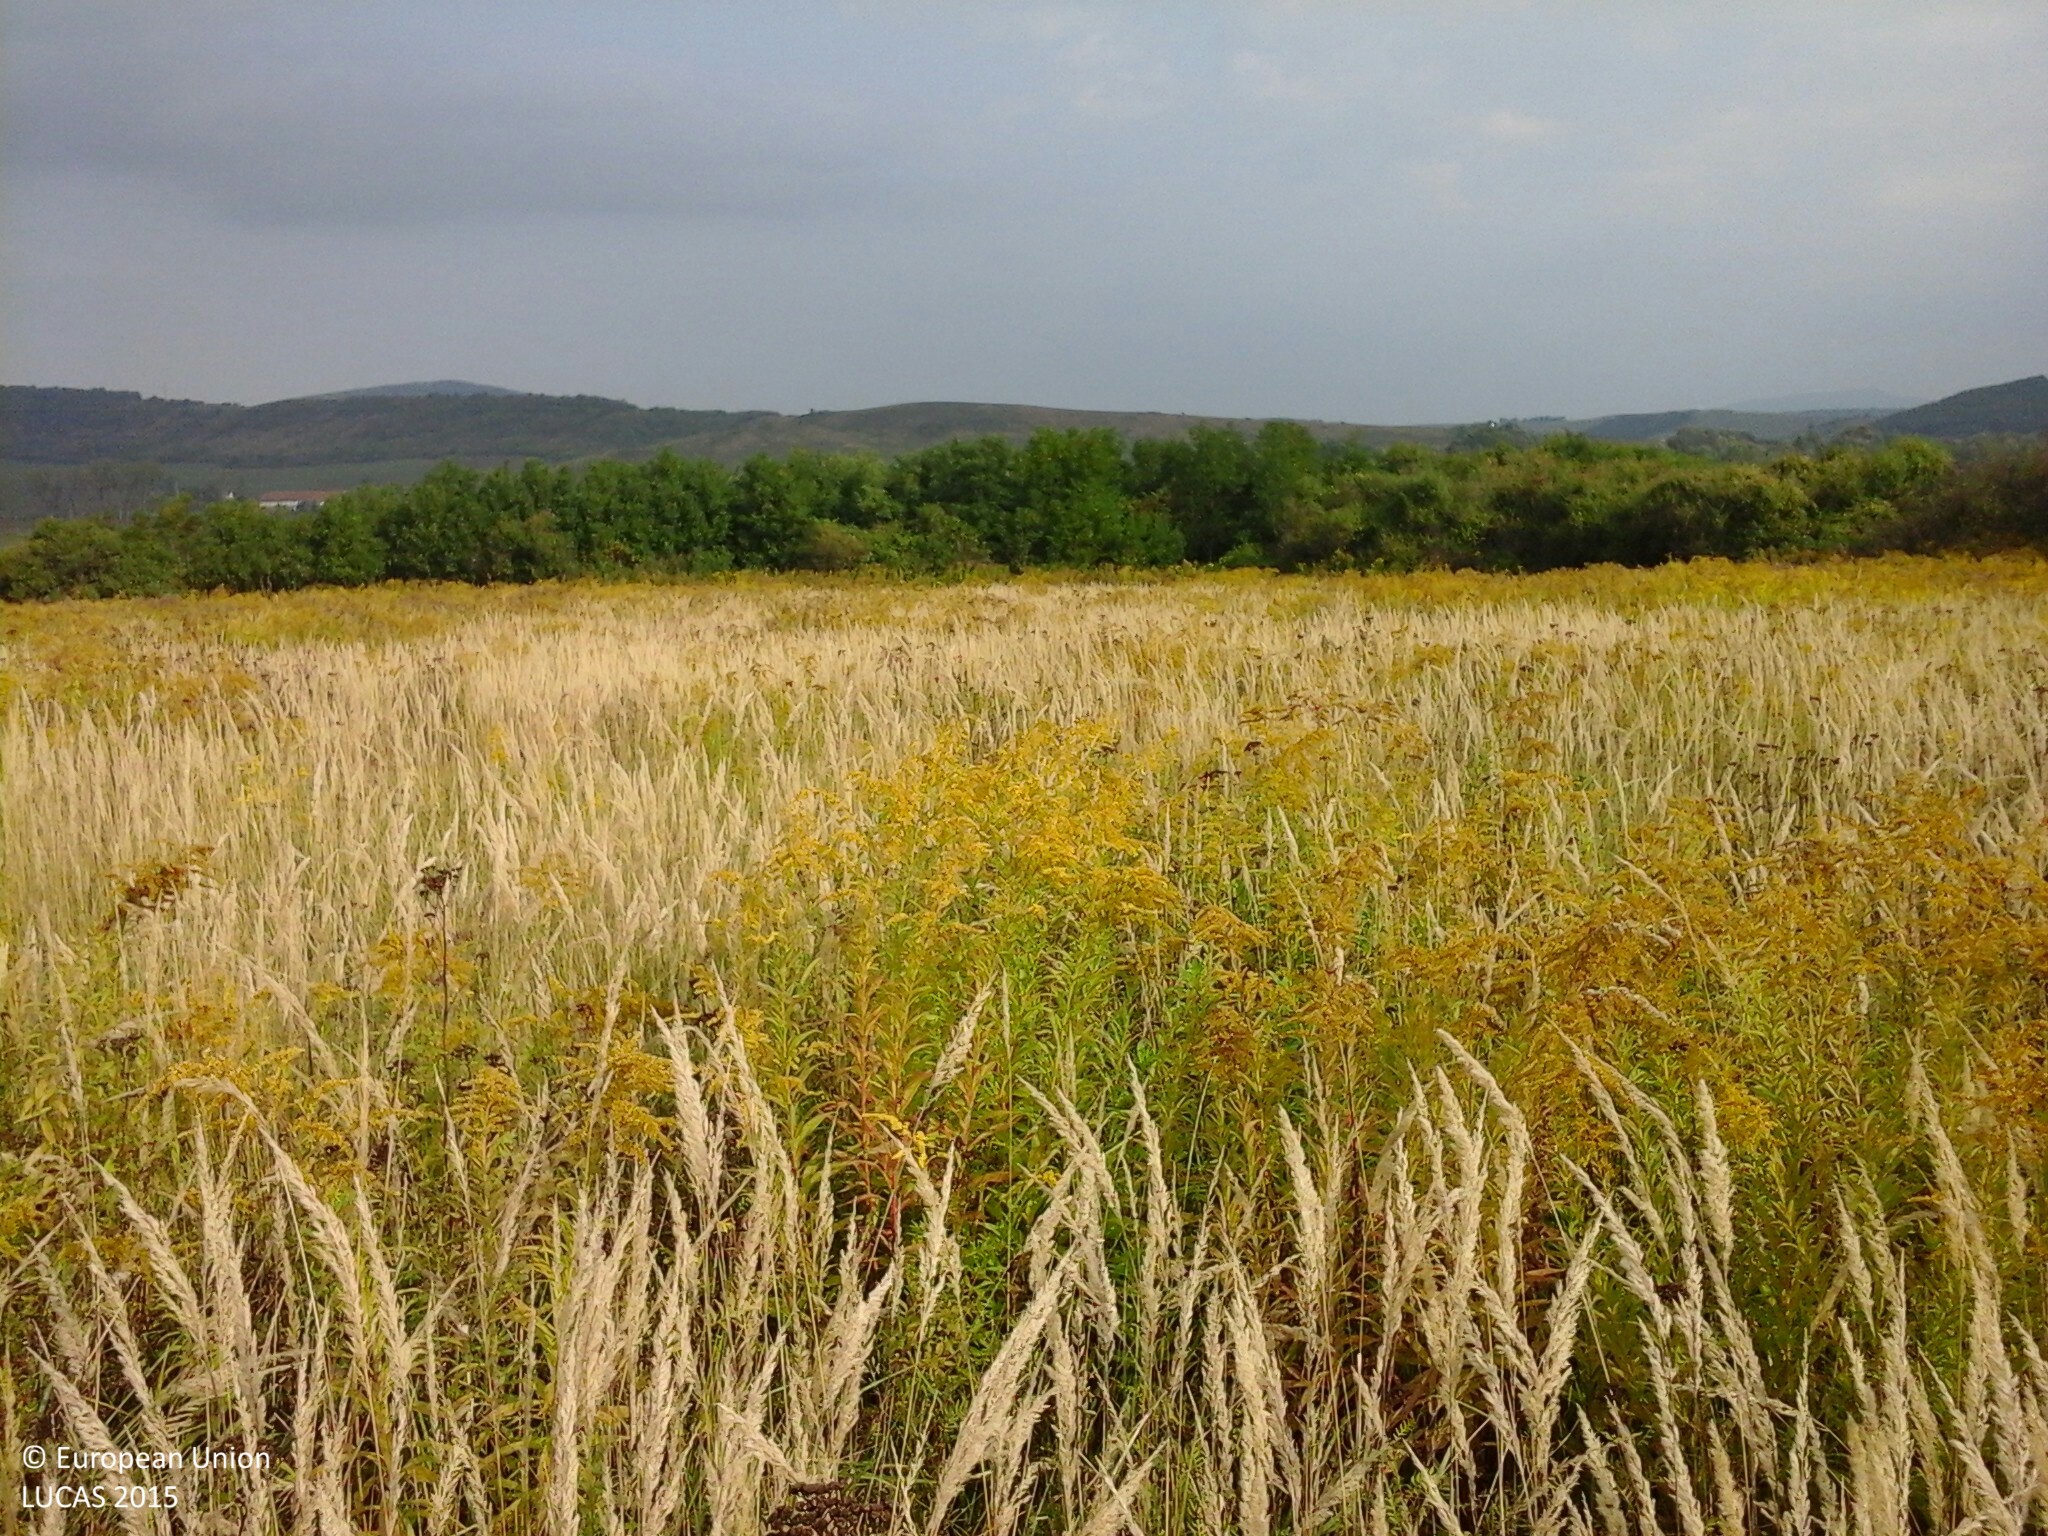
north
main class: Grassland
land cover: Spontaneously vegetated surfaces
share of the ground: > 75 %
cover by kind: herbaceous plants 100 %
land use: Abandoned areas
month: September
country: HU
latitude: 47.9680
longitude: 19.7903
